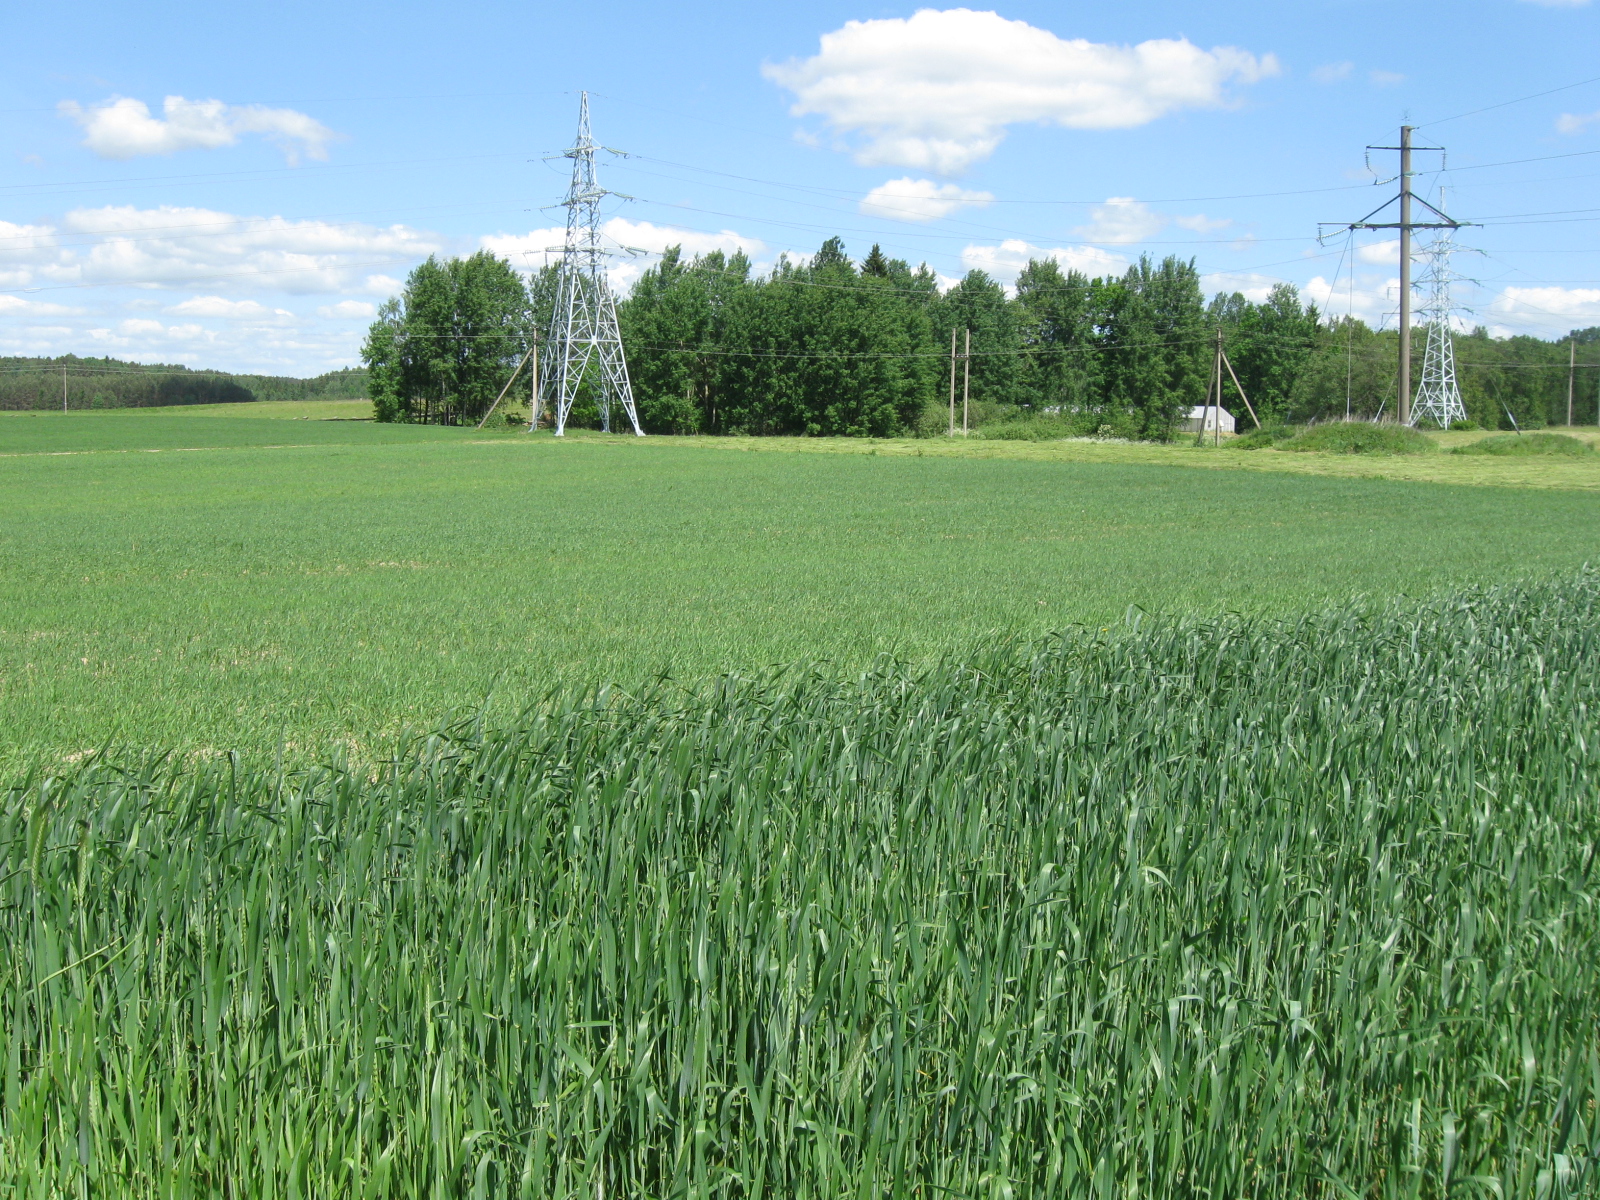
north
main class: Cropland
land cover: Common wheat
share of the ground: > 75 %
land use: Agriculture (excluding fallow land and kitchen gardens)
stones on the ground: < 10 %
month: June
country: LT
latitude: 54.5916
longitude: 23.8469
